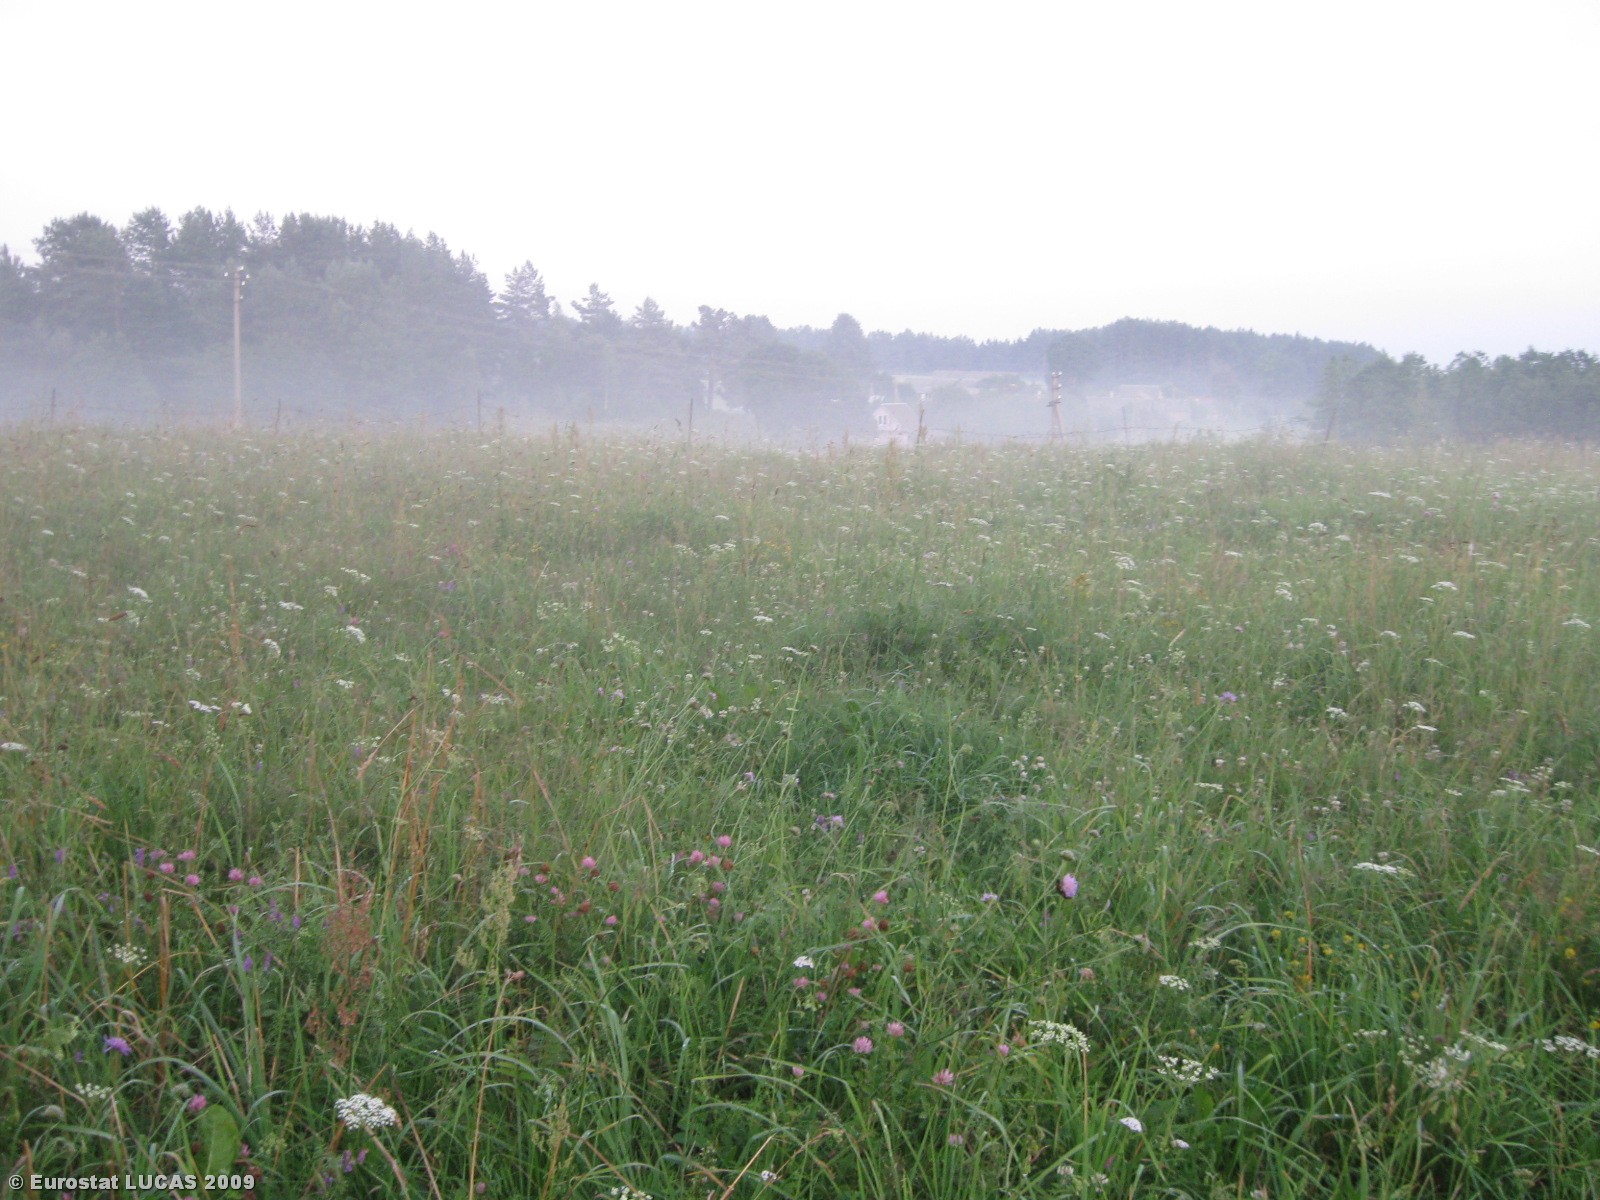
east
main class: Grassland
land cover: Grassland without tree/shrub cover
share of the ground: > 75 %
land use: Agriculture (excluding fallow land and kitchen gardens)
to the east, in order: Grassland without tree/shrub cover; Fences; Grassland without tree/shrub cover; Electric lines; Grassland without tree/shrub cover; Fences; Grassland without tree/shrub cover; Grassland with sparse tree/shrub cover; Inland water bodies; Grassland with sparse tree/shrub cover; Mixed woodland; Grassland without tree/shrub cover
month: July
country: LT
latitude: 54.2872
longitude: 25.0322
